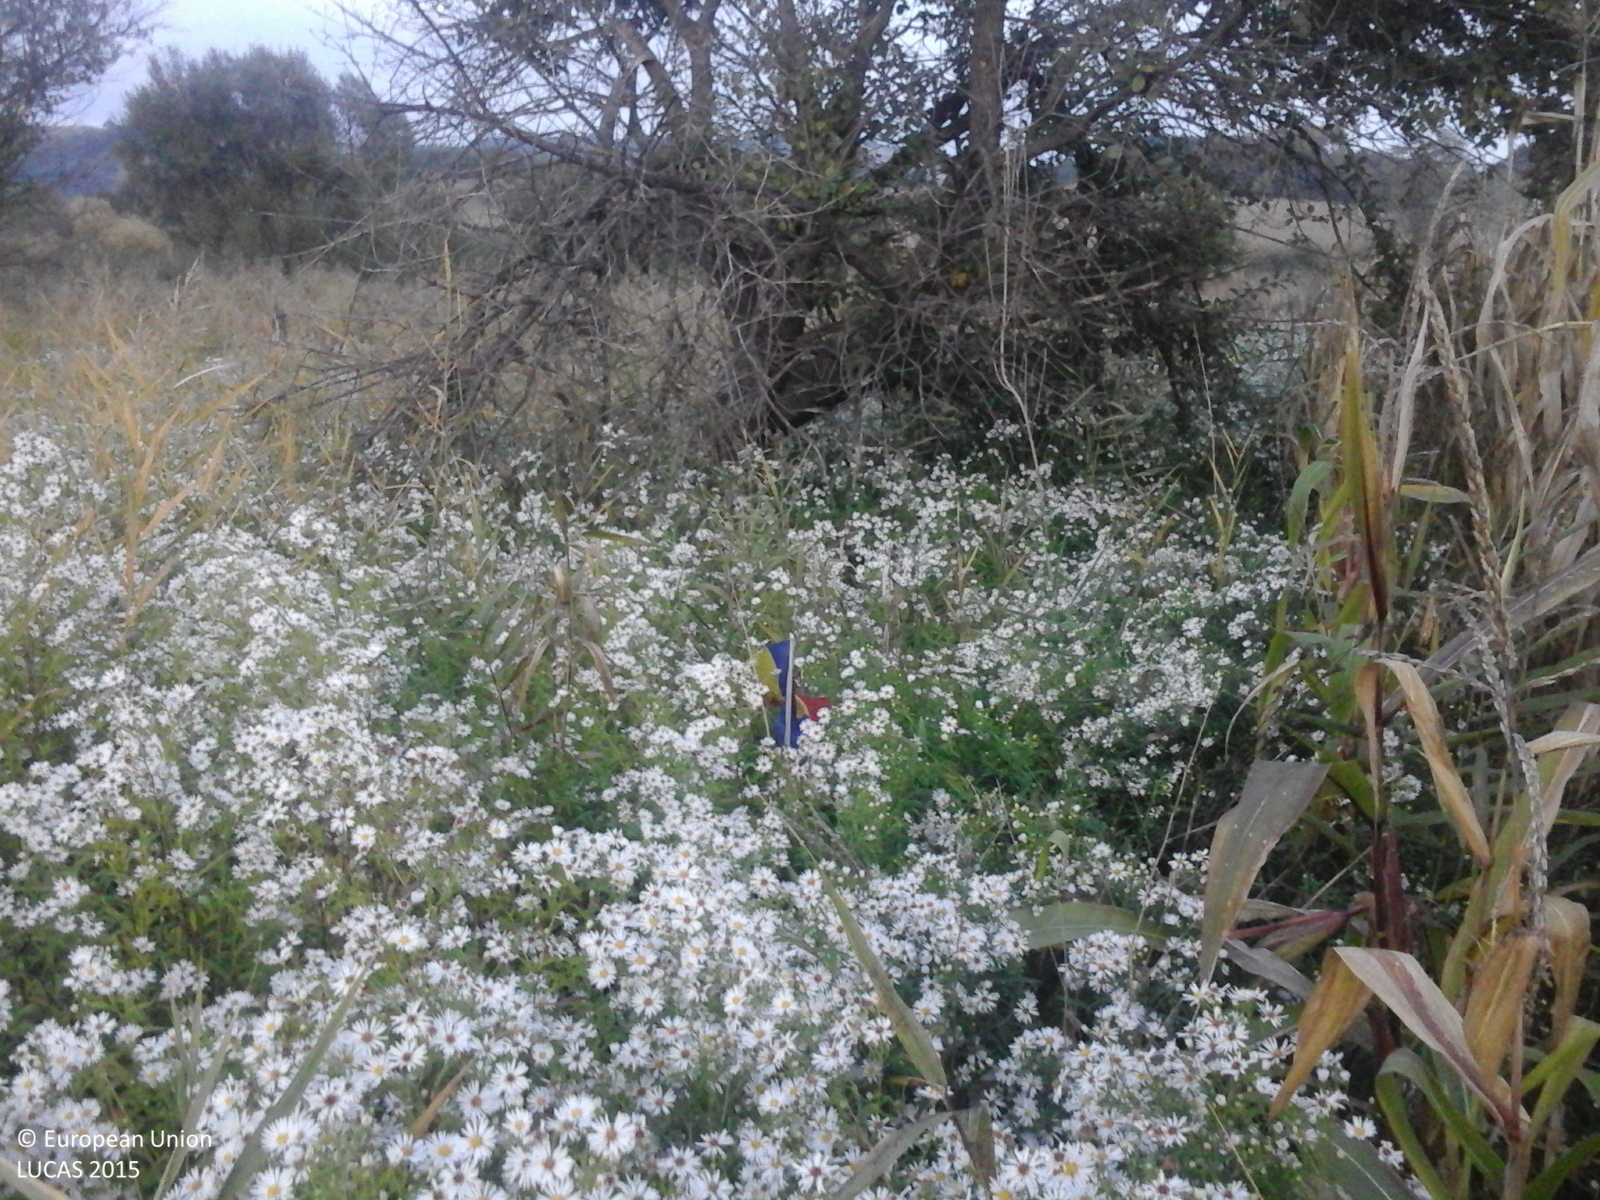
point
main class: Grassland
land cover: Spontaneously vegetated surfaces
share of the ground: > 75 %
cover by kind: herbaceous plants 100 %
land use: Fallow land
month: October
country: RO
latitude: 46.0023
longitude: 24.1910
